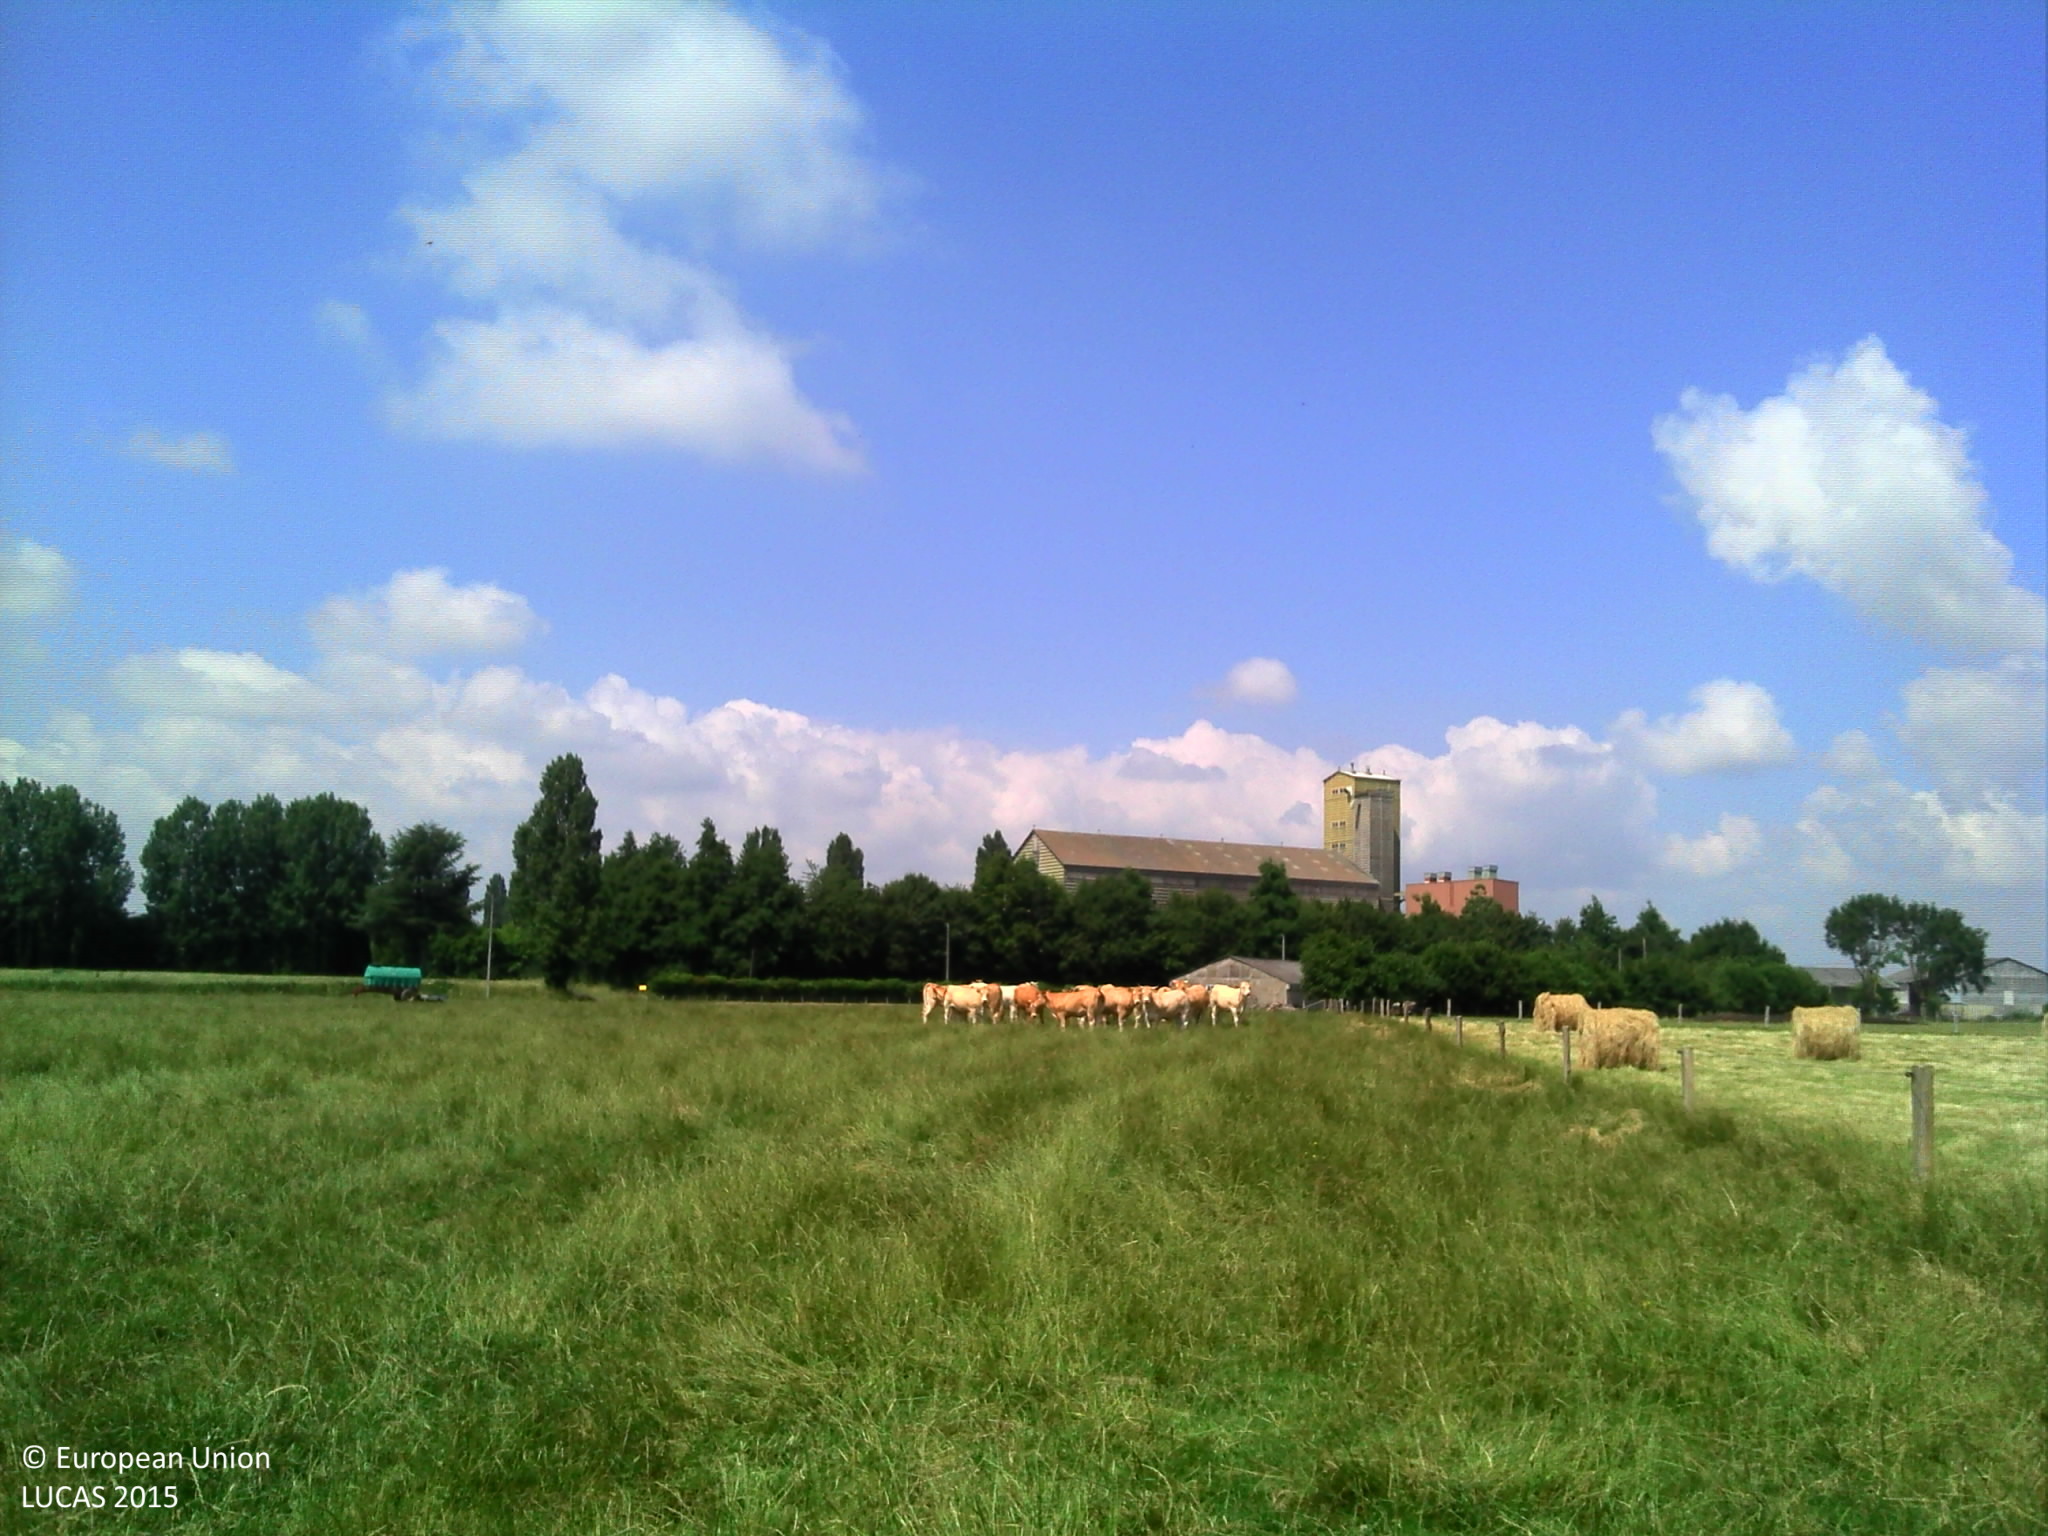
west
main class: Grassland
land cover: Grassland without tree/shrub cover
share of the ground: > 75 %
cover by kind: herbaceous plants 100 %
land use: Agriculture (excluding fallow land and kitchen gardens)
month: June
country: FR
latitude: 48.2448
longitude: 0.2646
